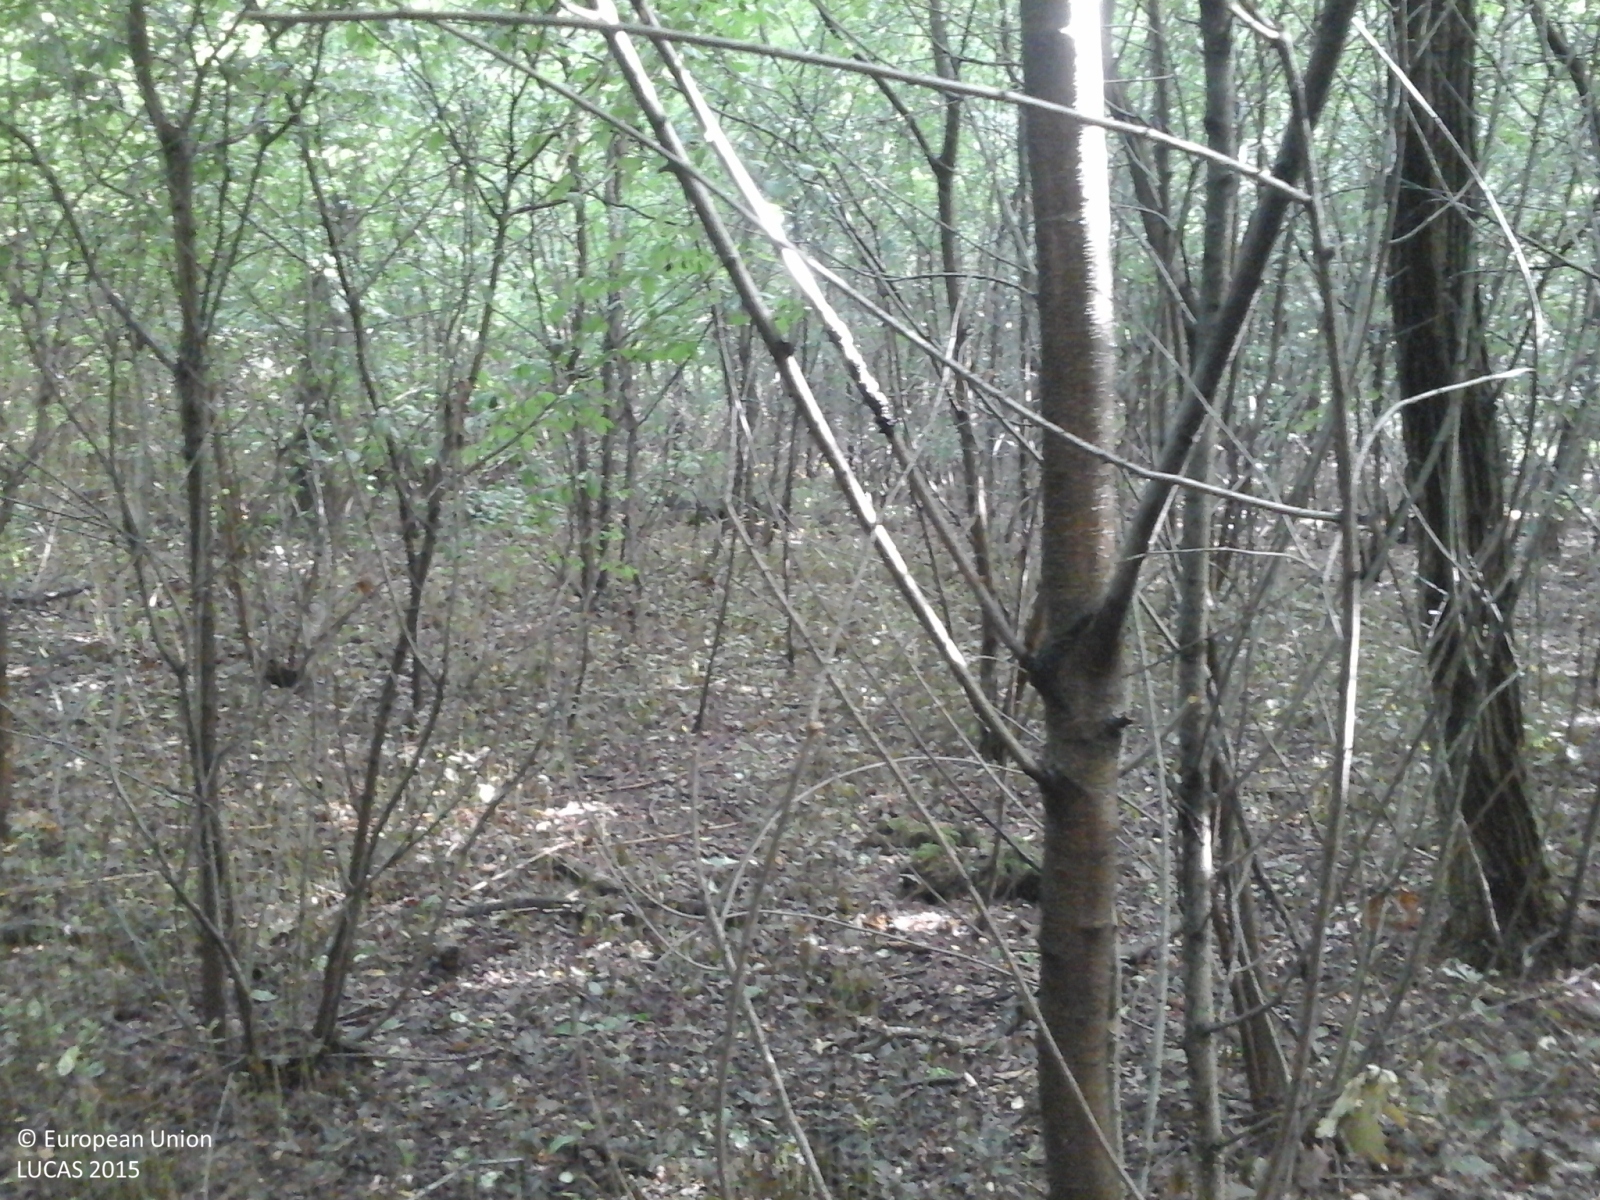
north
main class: Woodland
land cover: Broadleaved woodland
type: thermophilous deciduous forest
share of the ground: > 75 %
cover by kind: broadleaved forest trees 95 %, herbaceous plants 5 %
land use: Forestry
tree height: > 5 m
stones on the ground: < 10 %
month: June
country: IT
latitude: 45.6233
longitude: 8.7579
